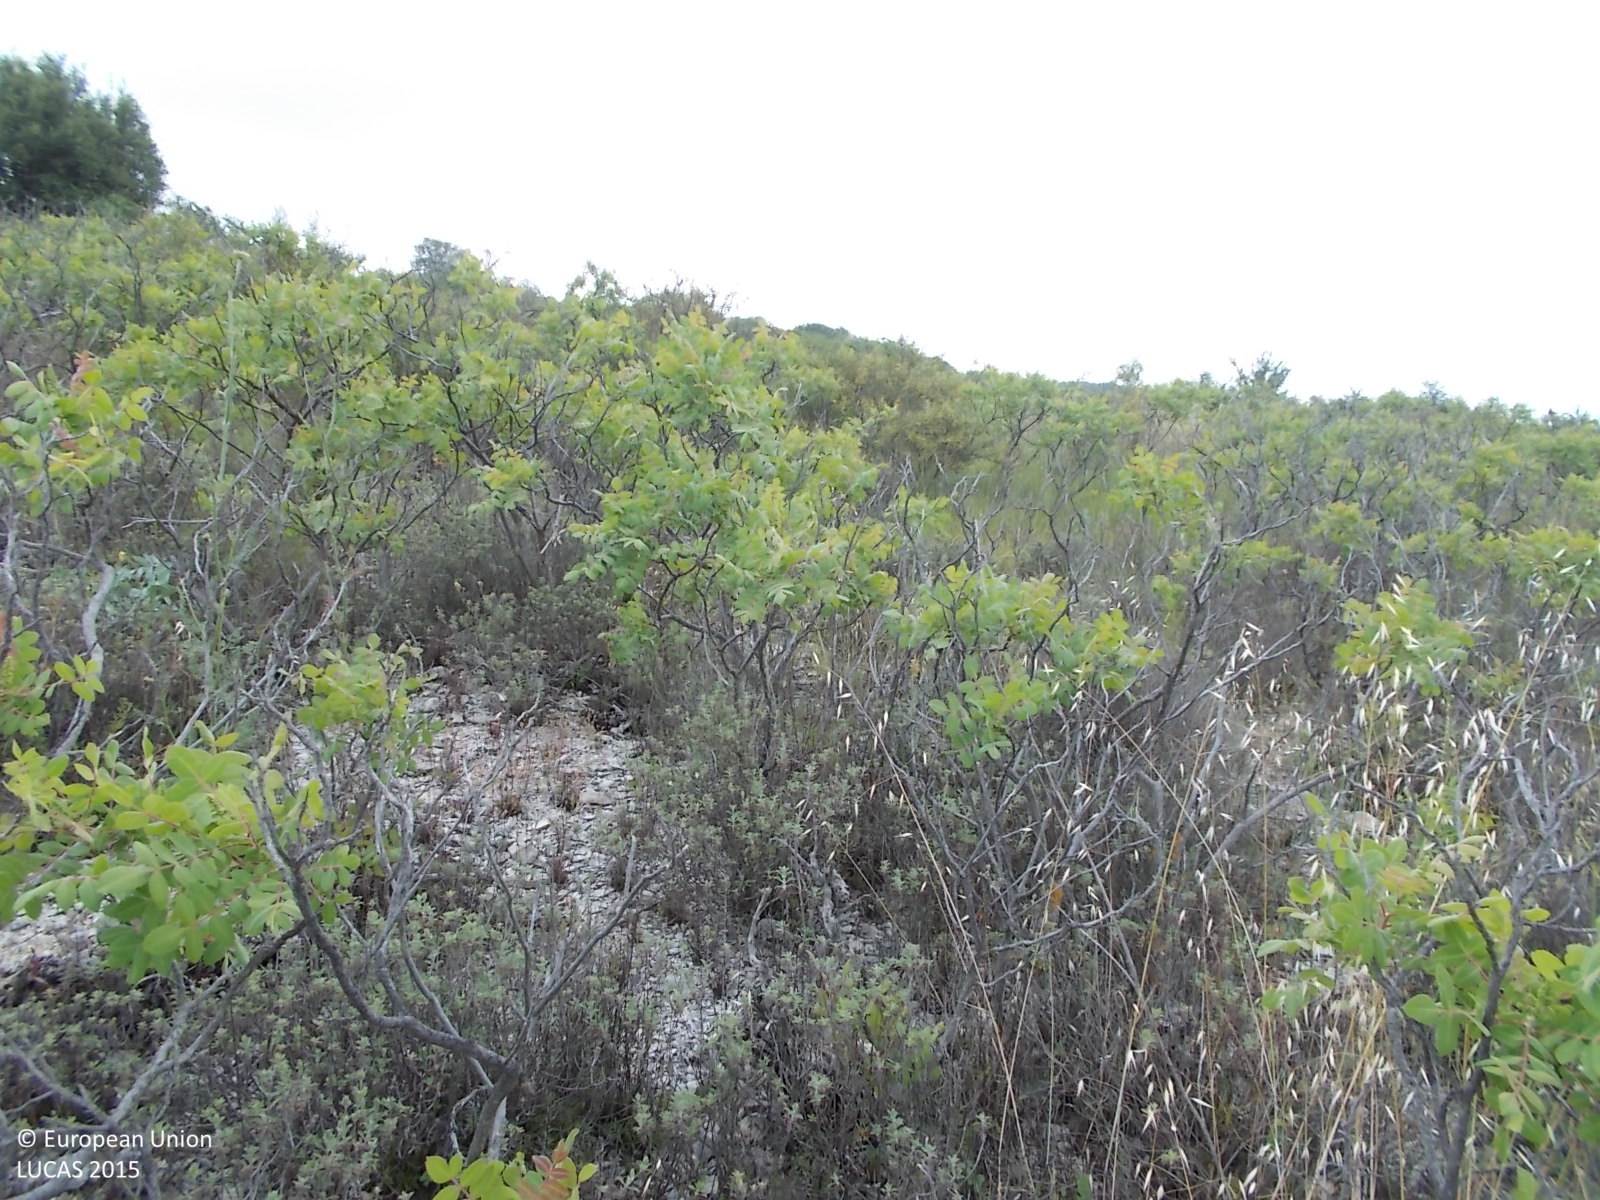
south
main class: Cropland
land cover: Cherry fruit
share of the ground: 50 - 75 %
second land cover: Shrubland without tree cover
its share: 25 - 50 %
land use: Abandoned areas
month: June
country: CY
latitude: 34.8545
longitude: 32.8360
